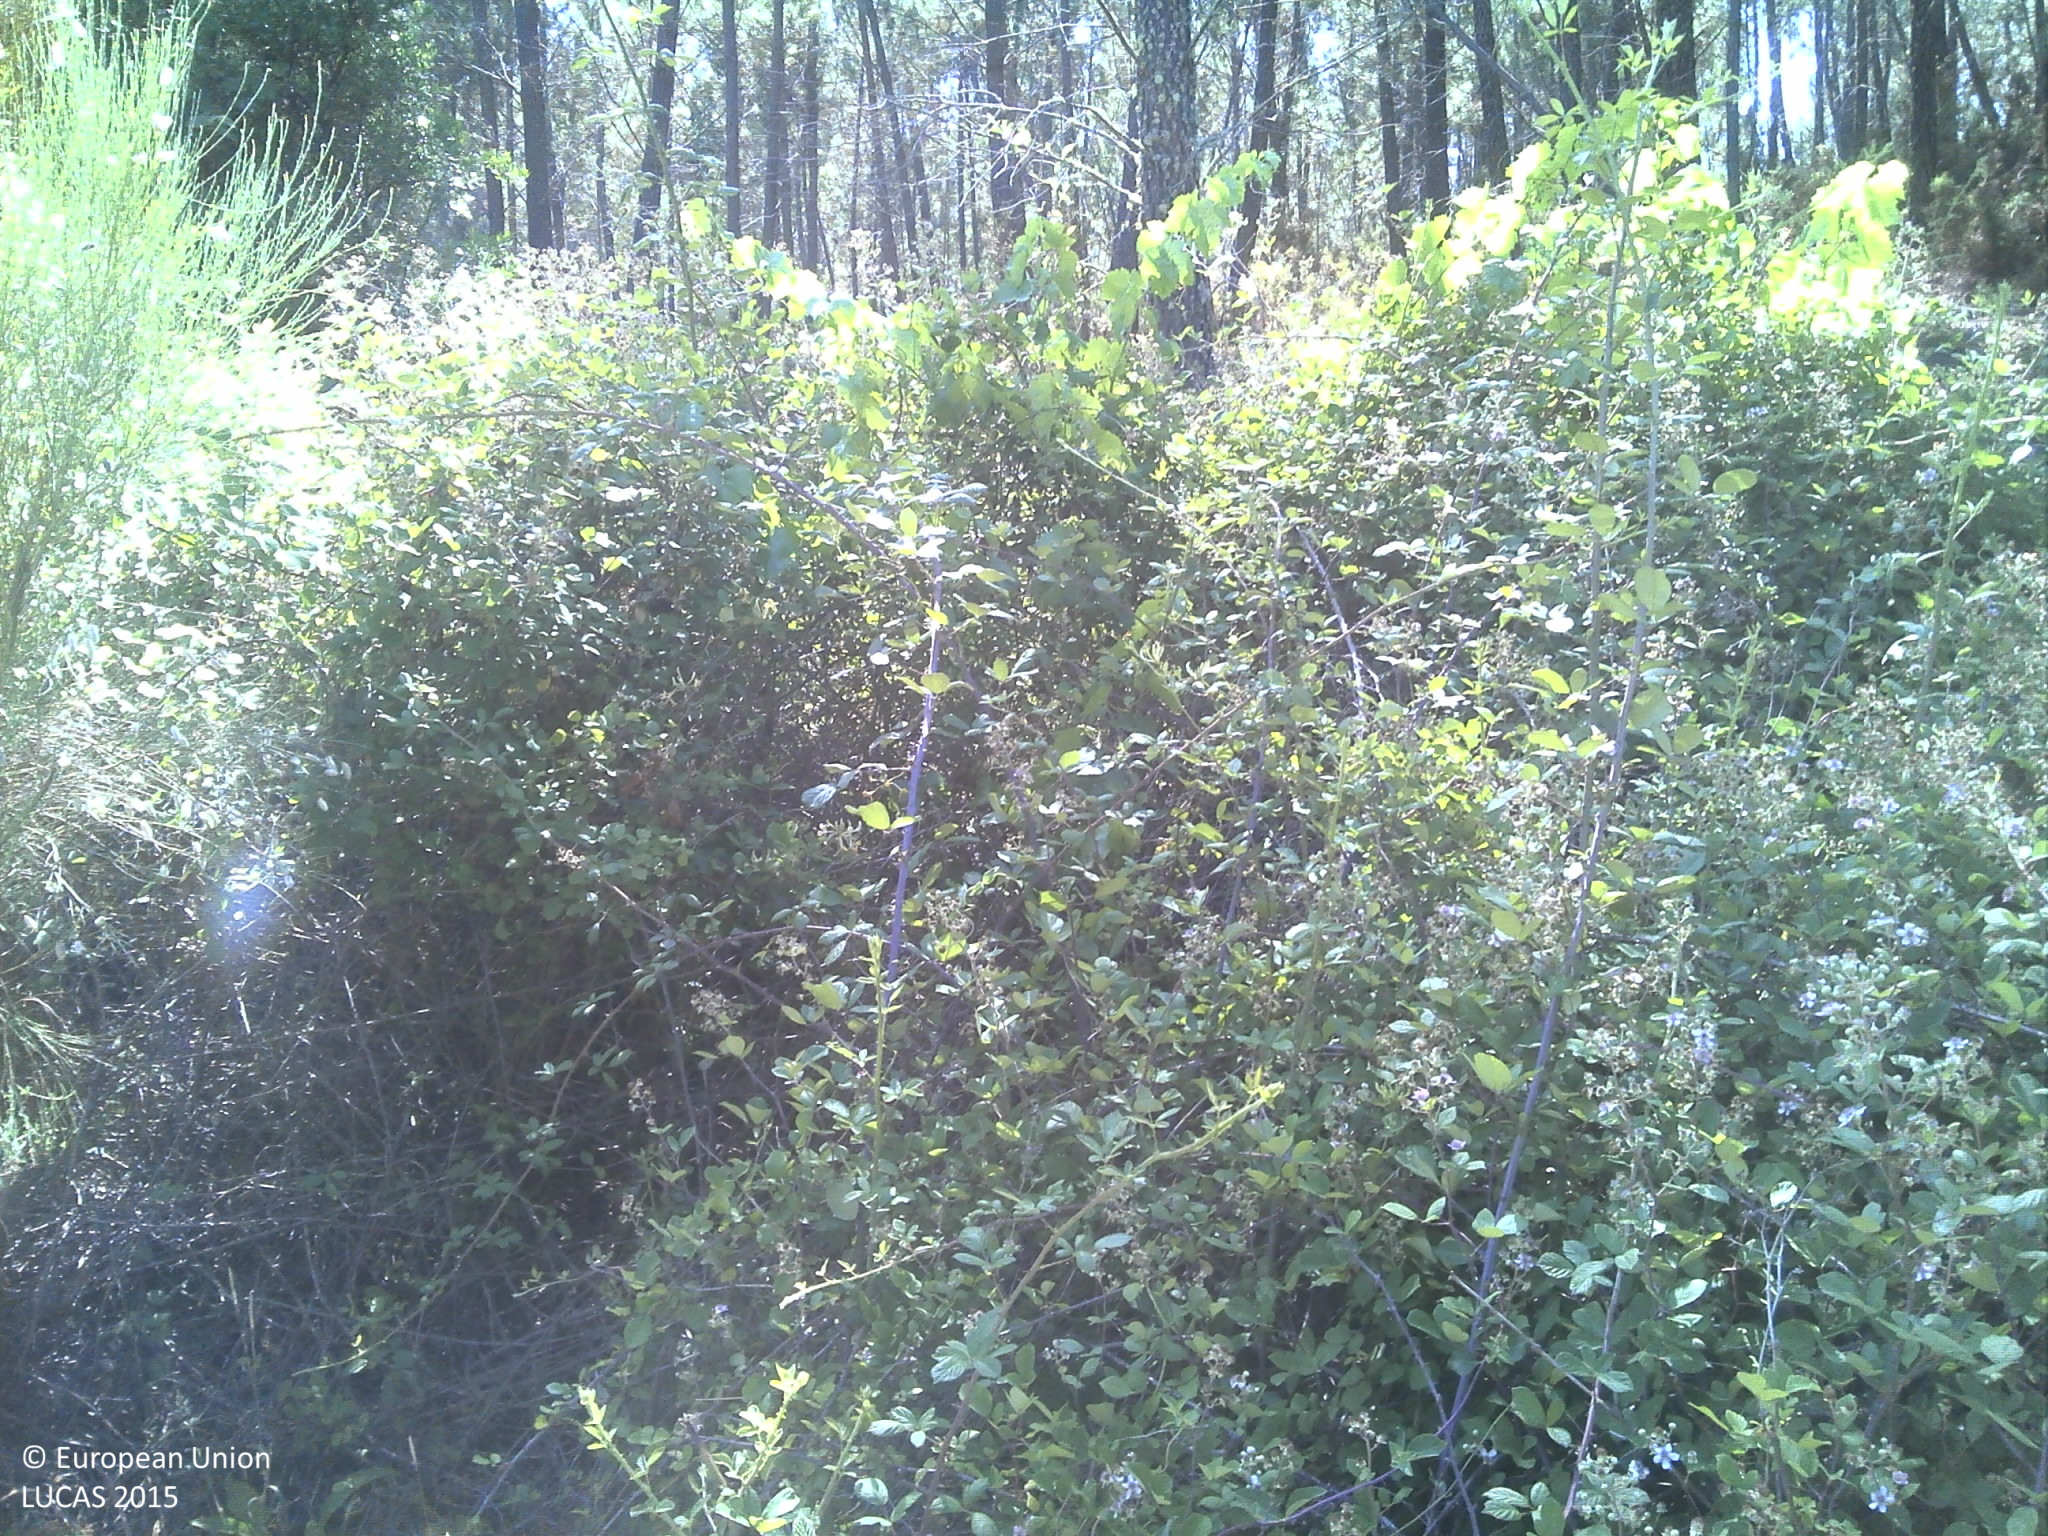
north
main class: Woodland
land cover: Pine dominated coniferous woodland
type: coniferous forest of the mediterranean region
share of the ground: 25 - 50 %
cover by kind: coniferous forest trees 50 %, shrubs 35 %, unconsolidated bare surface 15 %
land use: Forestry
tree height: > 5 m
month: July
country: PT
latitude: 39.9645
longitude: -7.8469
